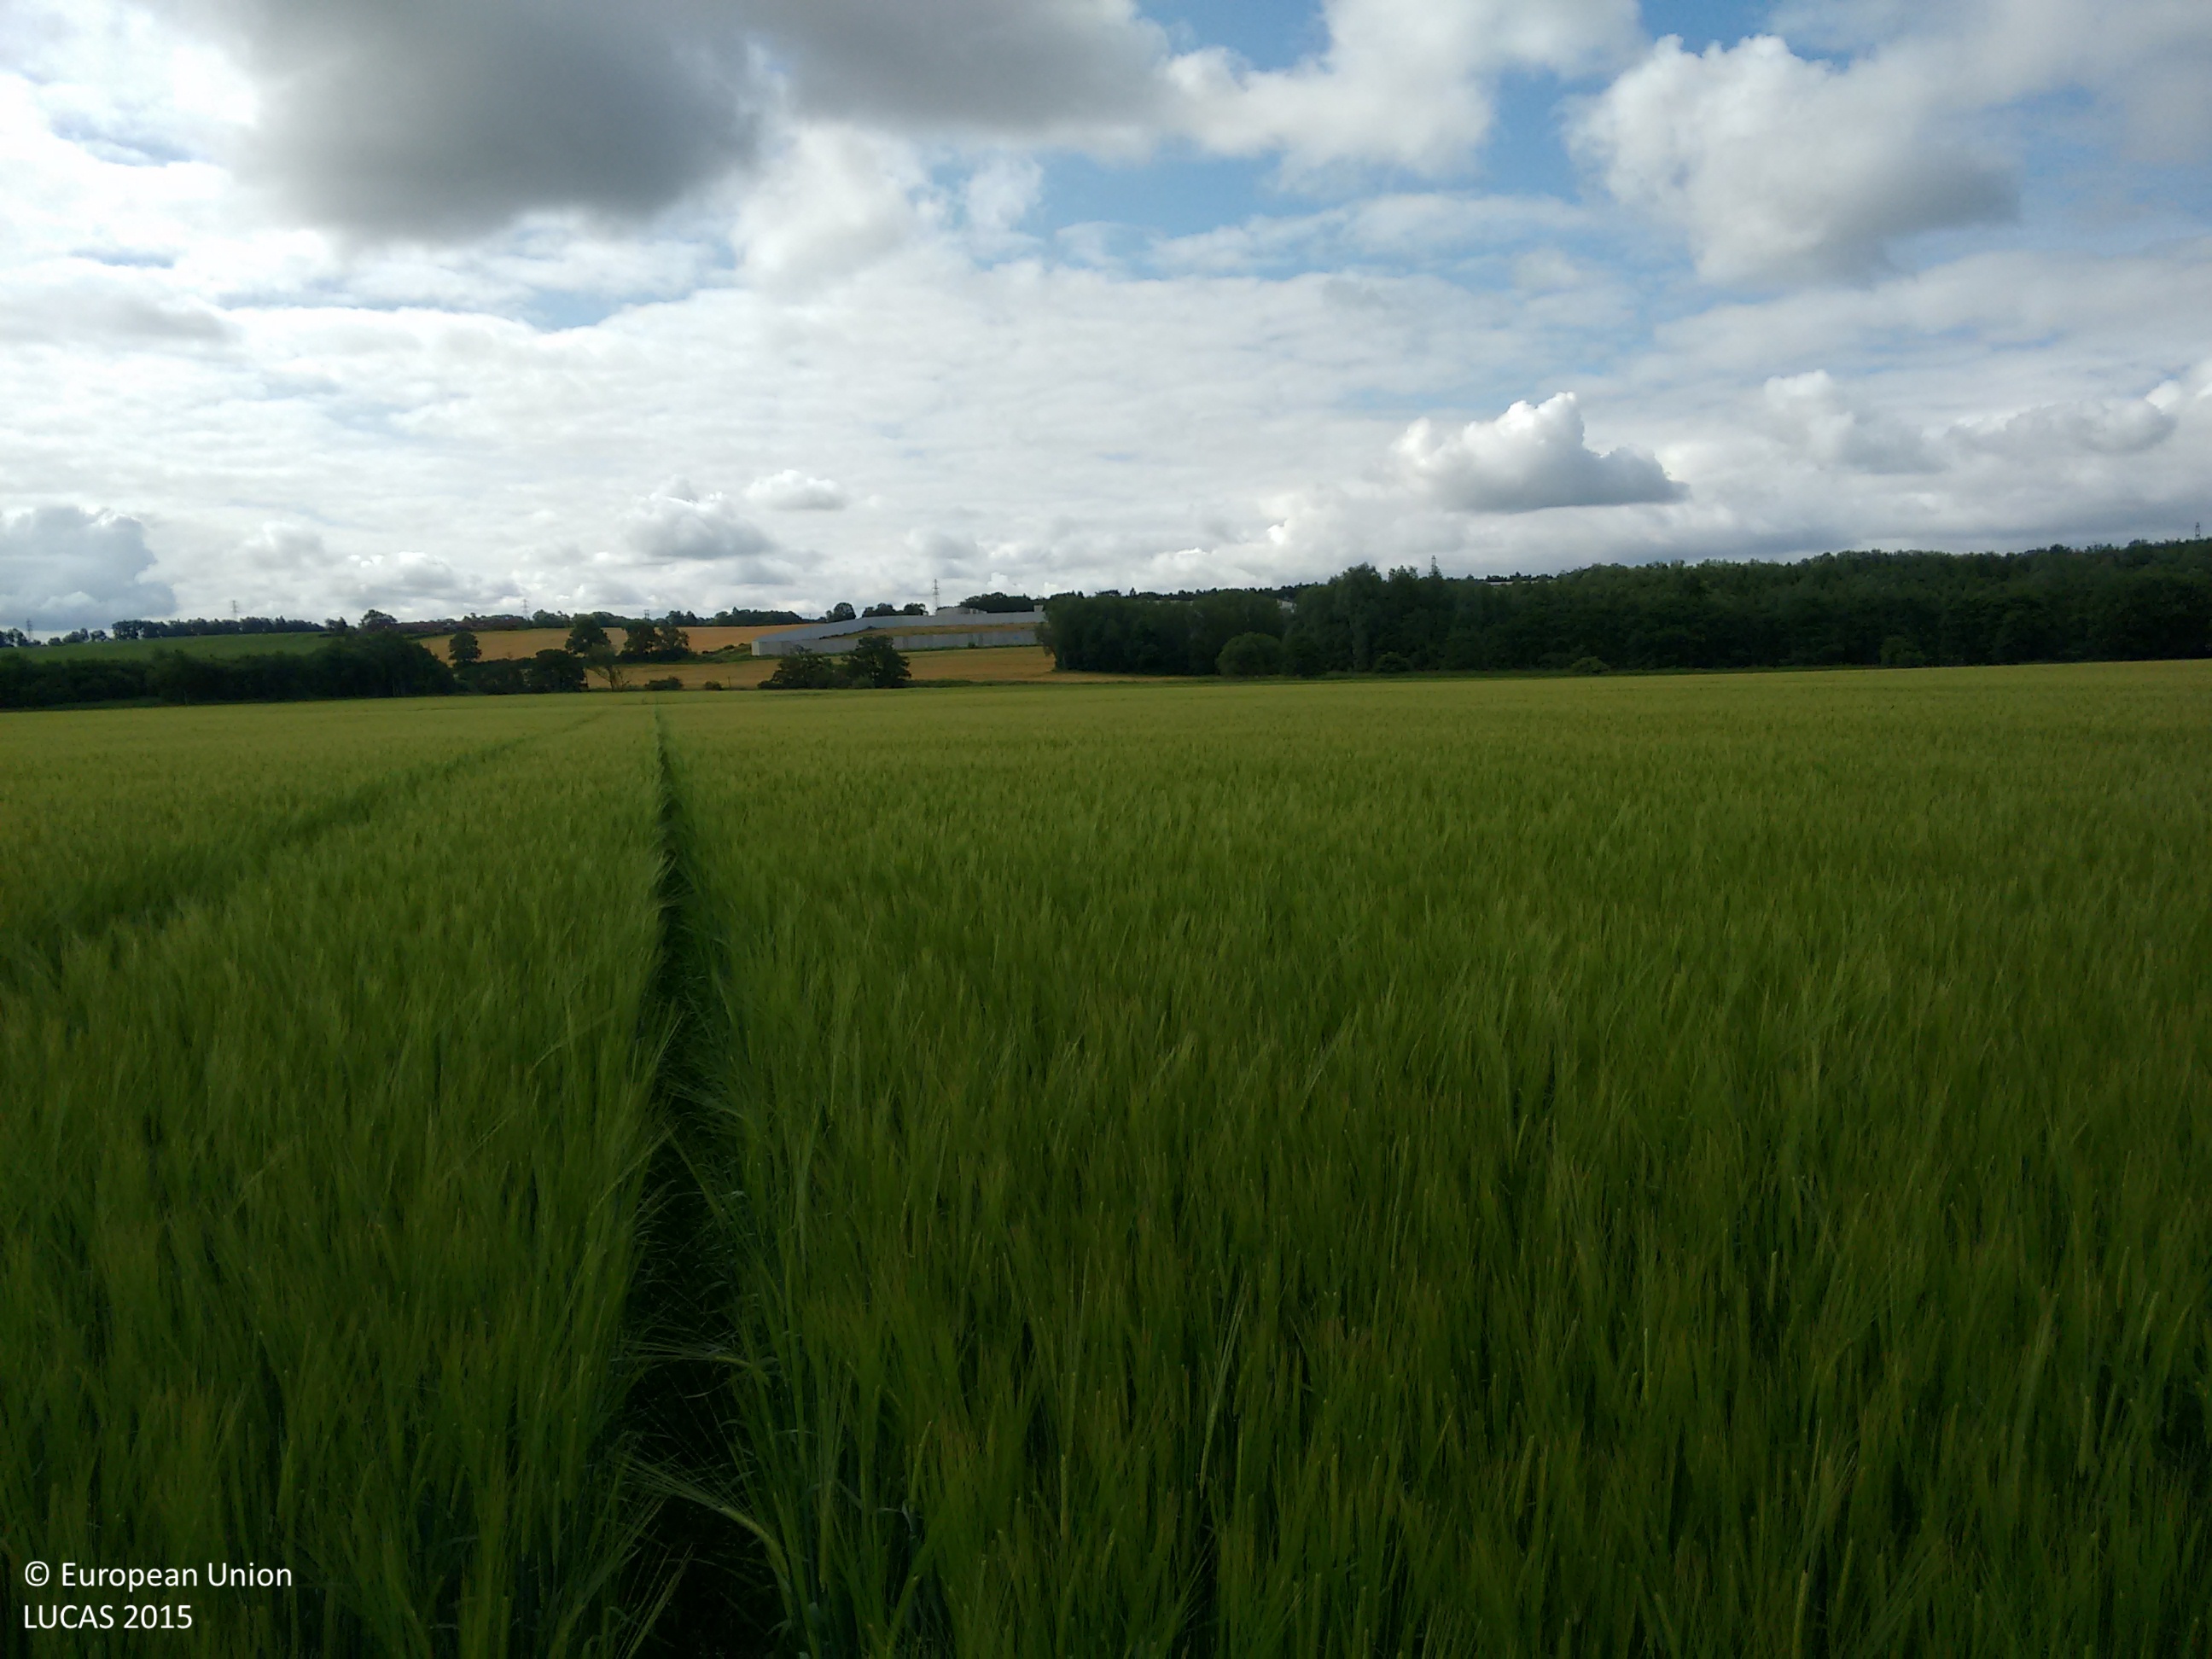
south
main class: Cropland
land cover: Barley
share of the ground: > 75 %
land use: Agriculture (excluding fallow land and kitchen gardens)
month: July
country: GB
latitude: 56.1485
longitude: -3.8132
